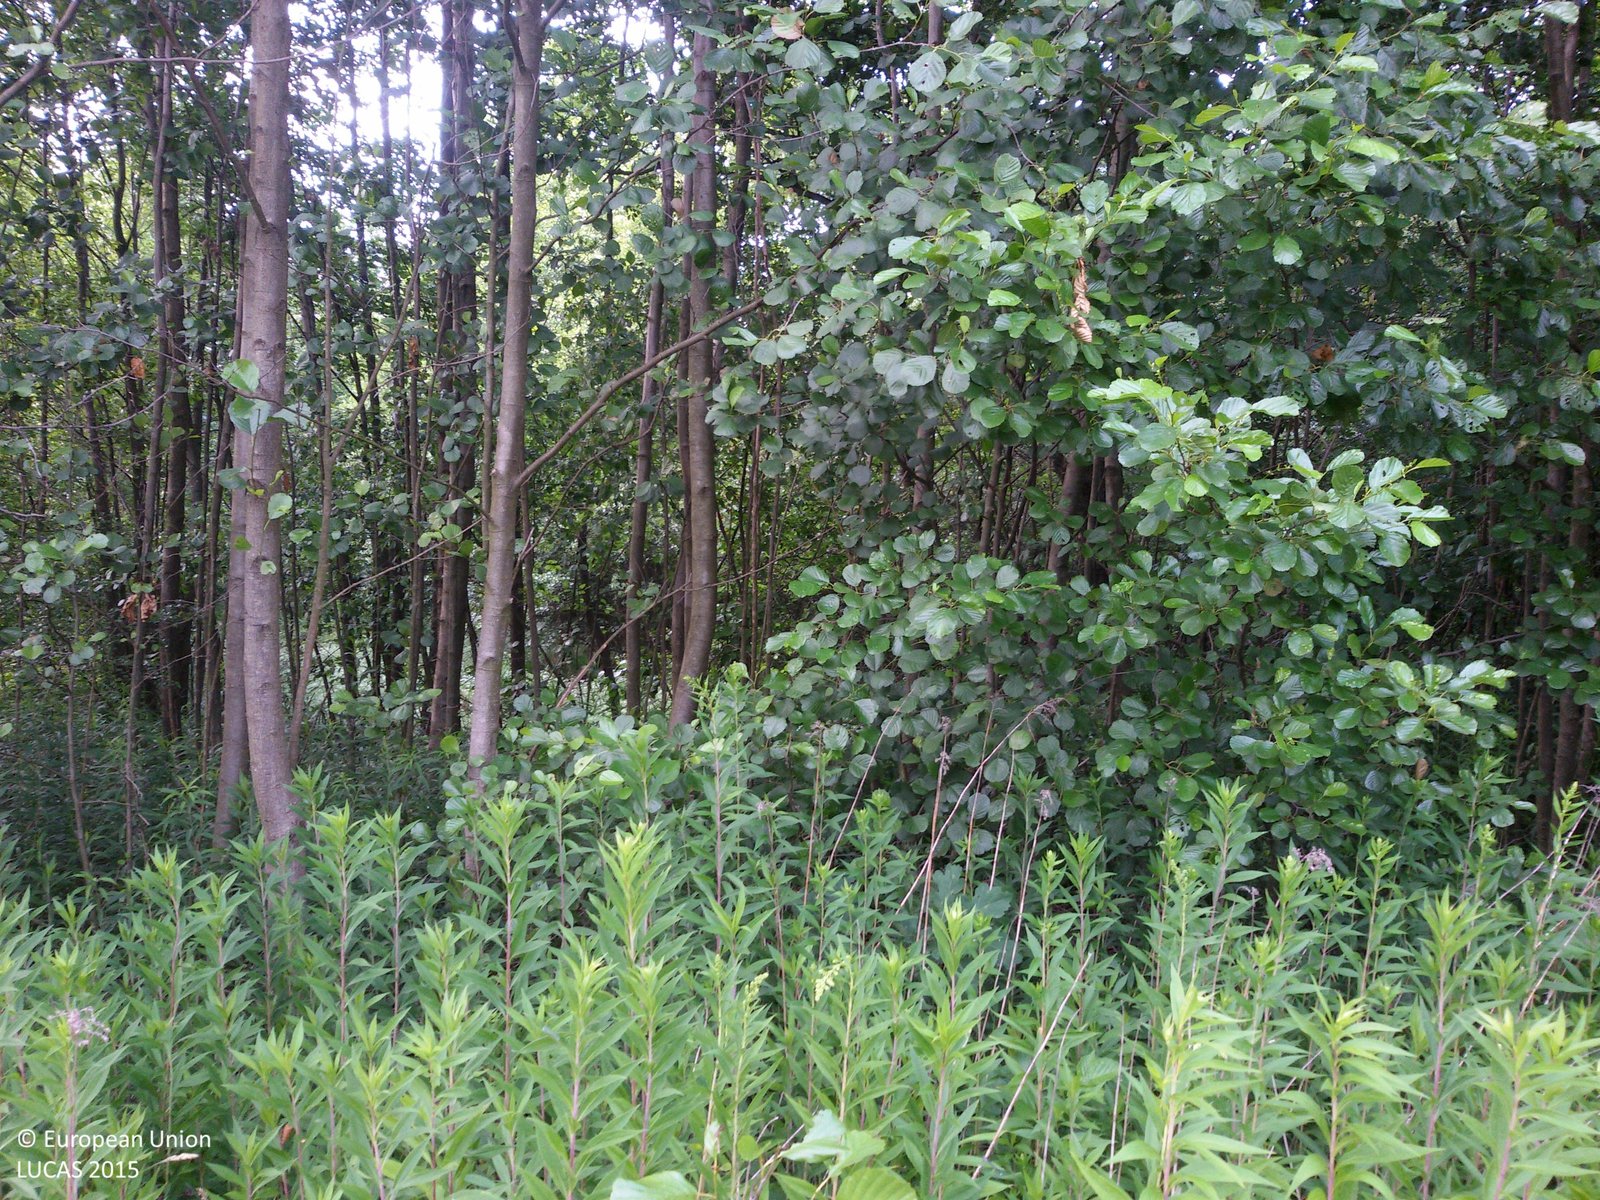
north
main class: Woodland
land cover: Broadleaved woodland
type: mesophytic deciduous forest
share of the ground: > 75 %
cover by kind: broadleaved forest trees 75 %, herbaceous plants 15 %, shrubs 10 %
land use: Semi-natural and natural areas not in use
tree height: > 5 m
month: July
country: PL
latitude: 52.7708
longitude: 19.0799
